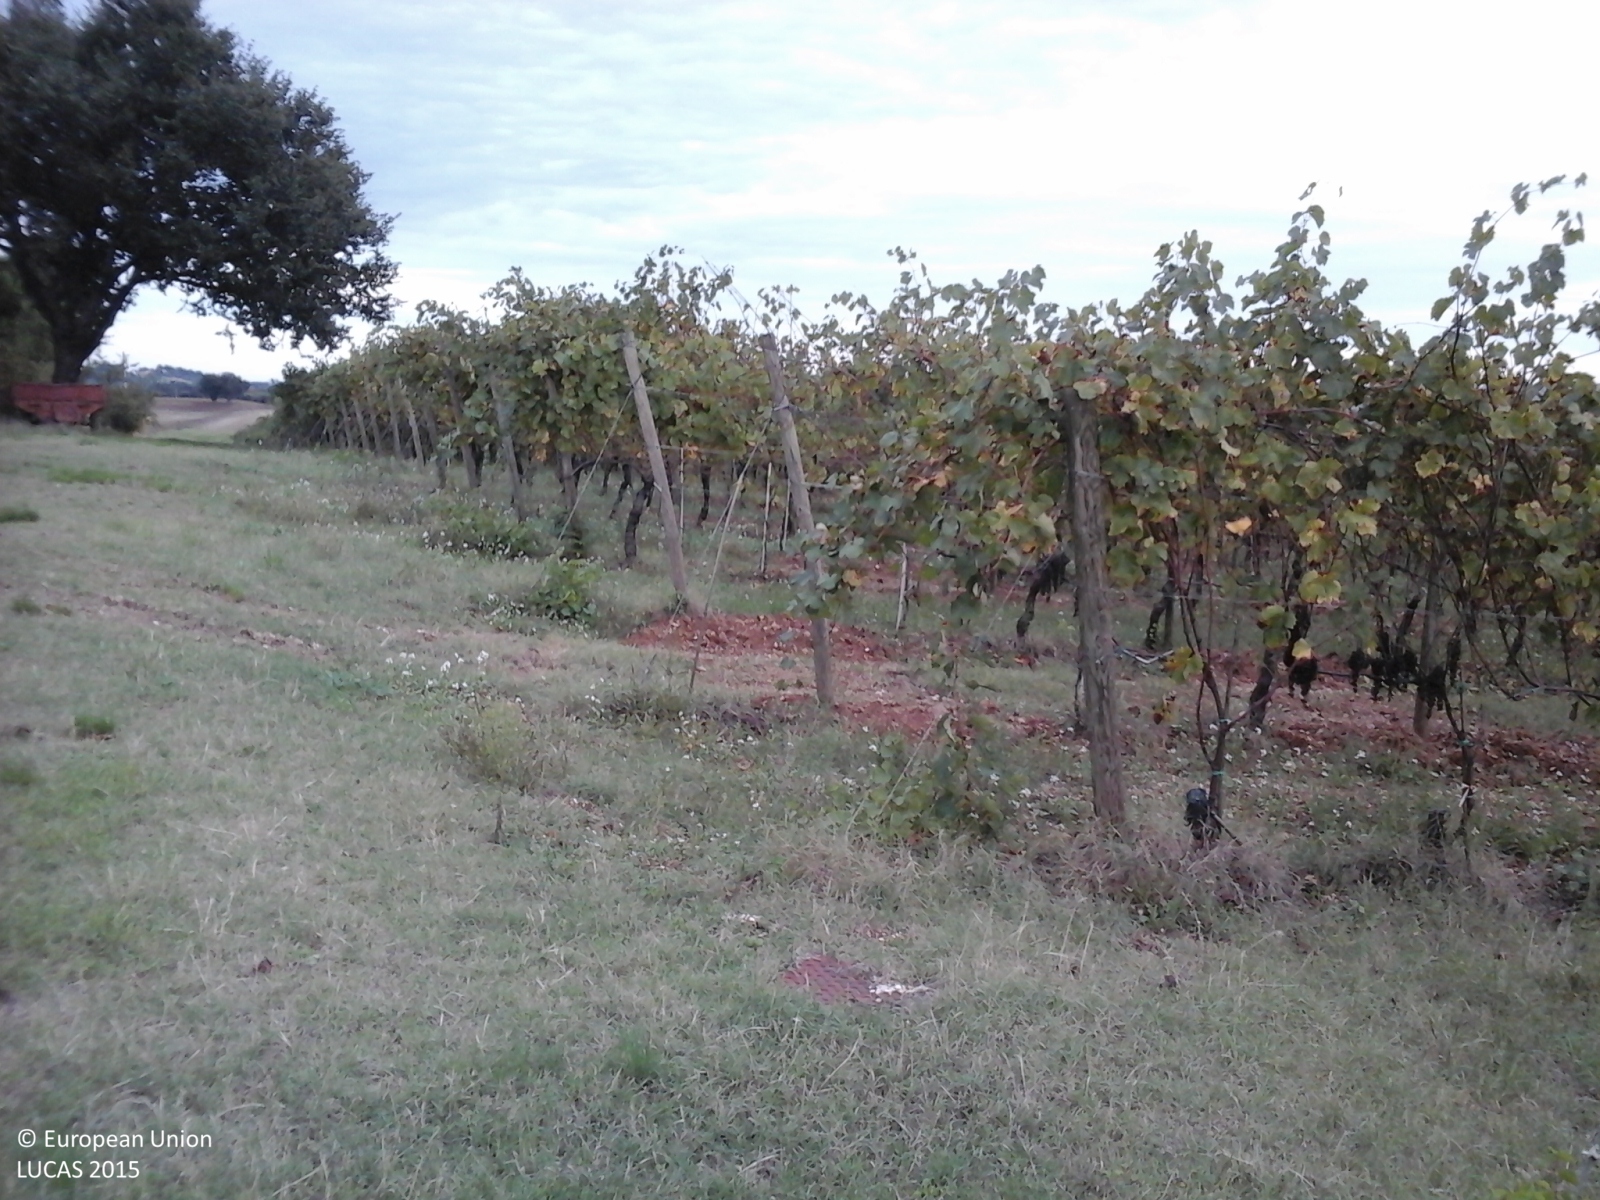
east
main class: Grassland
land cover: Grassland without tree/shrub cover
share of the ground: 25 - 50 %
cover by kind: herbaceous plants 100 %
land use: Agriculture (excluding fallow land and kitchen gardens)
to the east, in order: Grassland without tree/shrub cover; Vineyards; Single bushes/trees; Paved roads, cycling and walking lanes; Managed hedges; Vineyards; Electric lines; Vineyards; Other bare soil
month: October
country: IT
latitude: 43.5085
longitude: 13.1463
